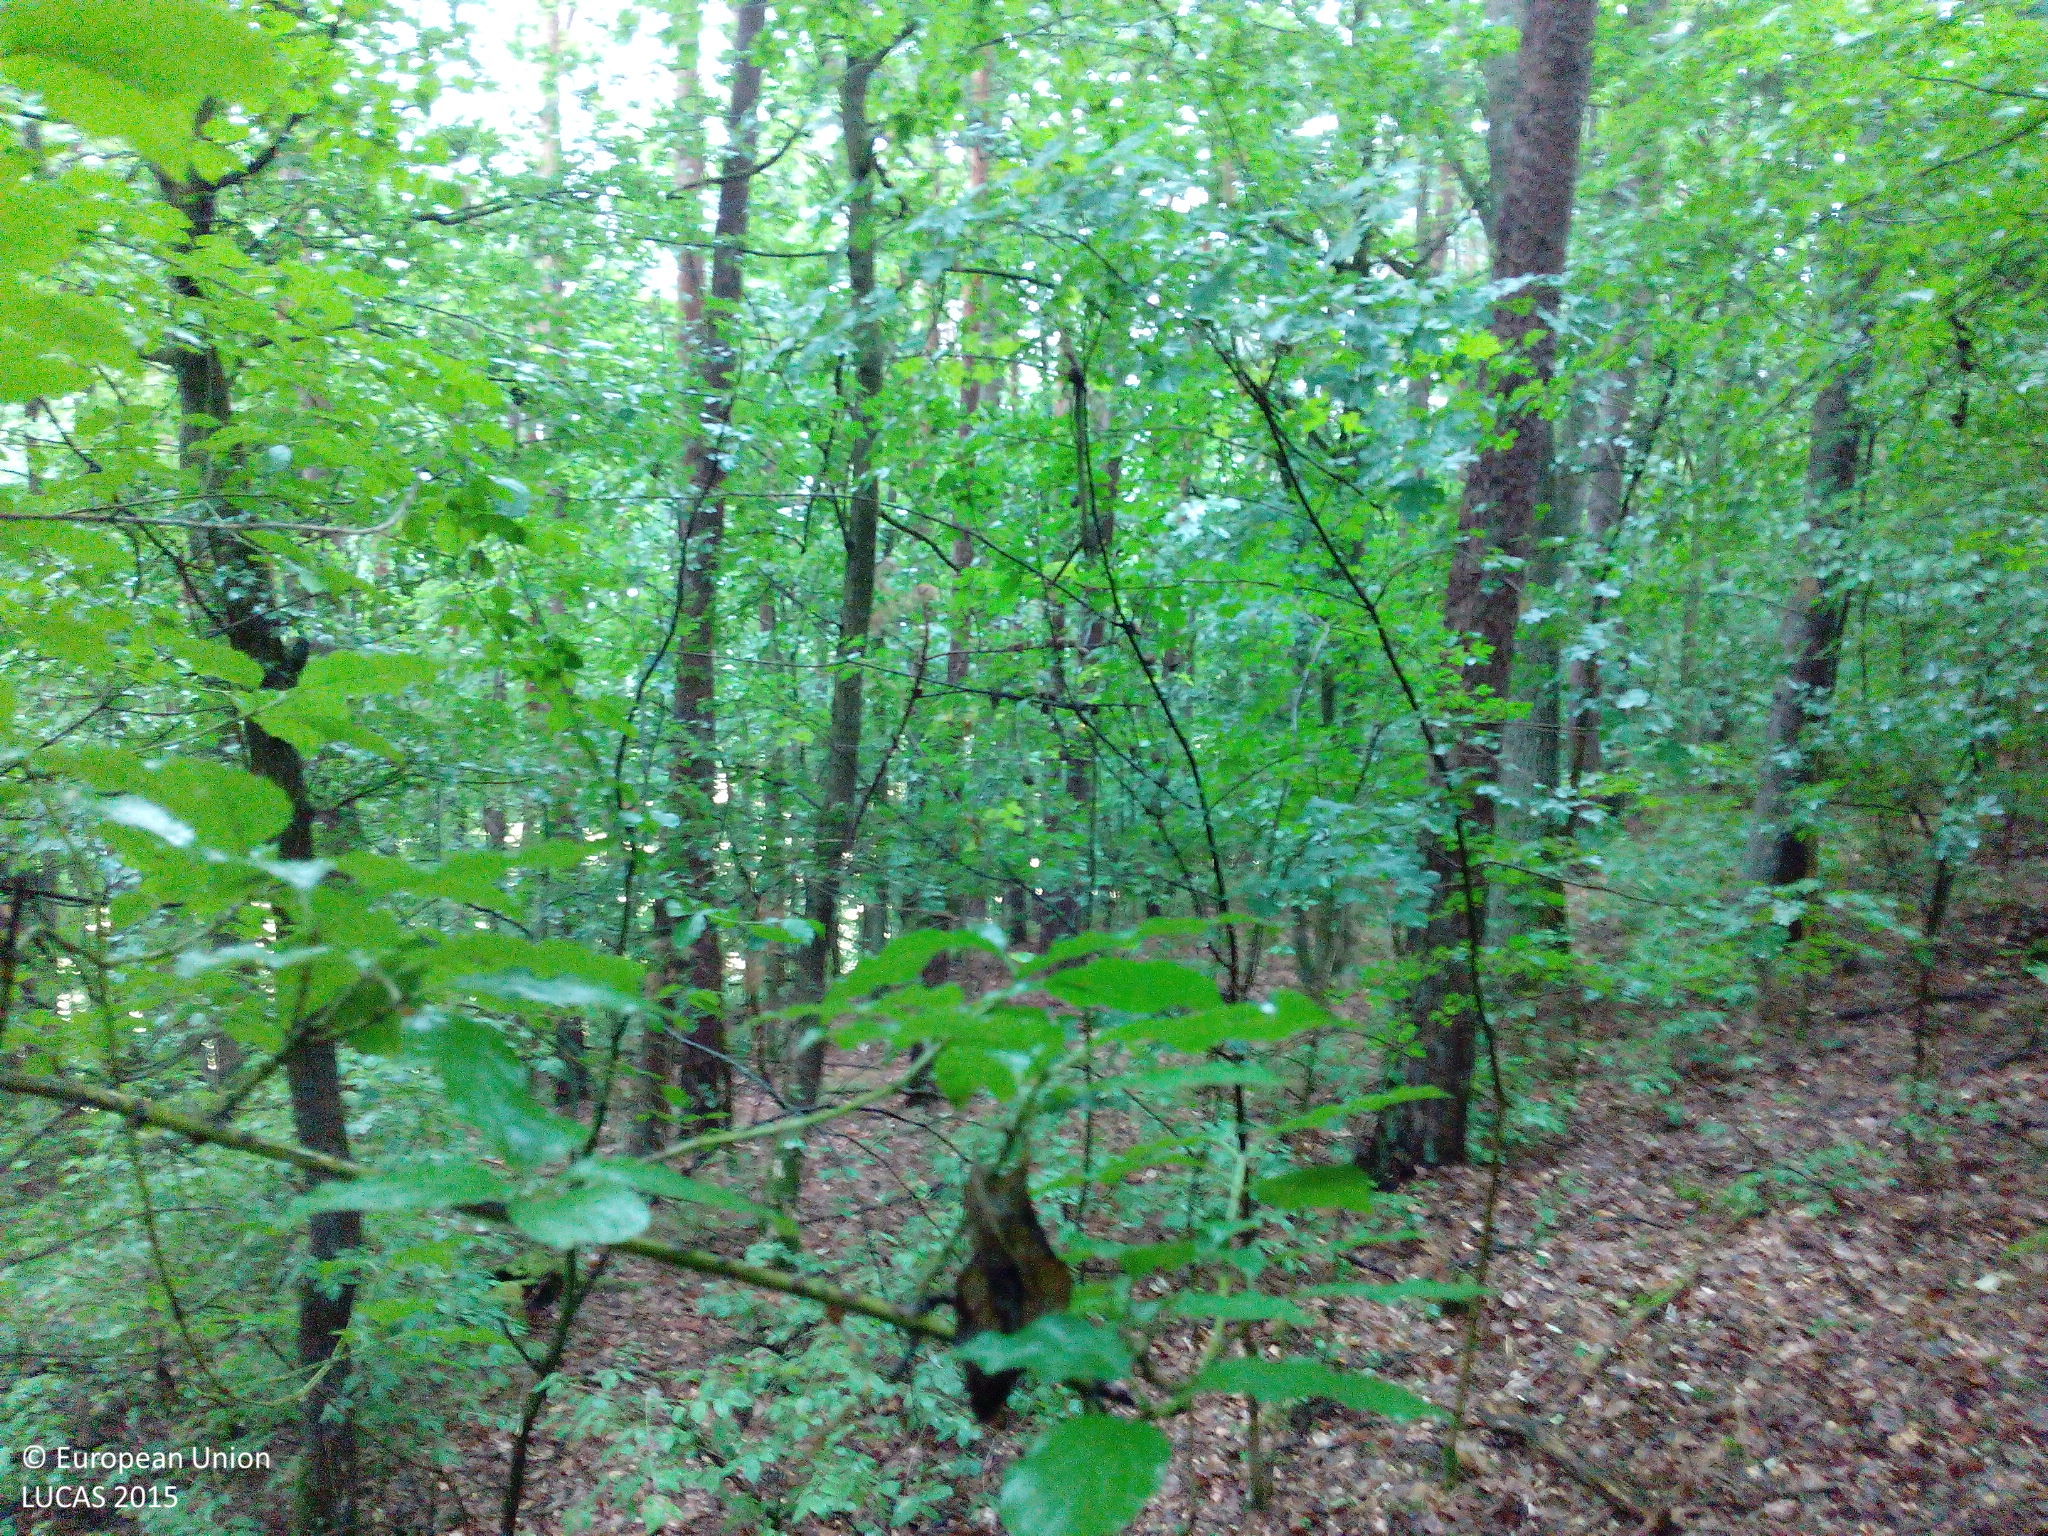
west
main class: Woodland
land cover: Pine dominated mixed woodland
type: hemiboreal forest and nemoral coniferous forest and mixed broadleaved-coniferous forest
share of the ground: > 75 %
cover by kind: coniferous forest trees 65 %, broadleaved forest trees 30 %, unconsolidated bare surface 5 %
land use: Forestry
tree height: > 5 m
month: June
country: DE
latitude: 50.1021
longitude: 11.5235
